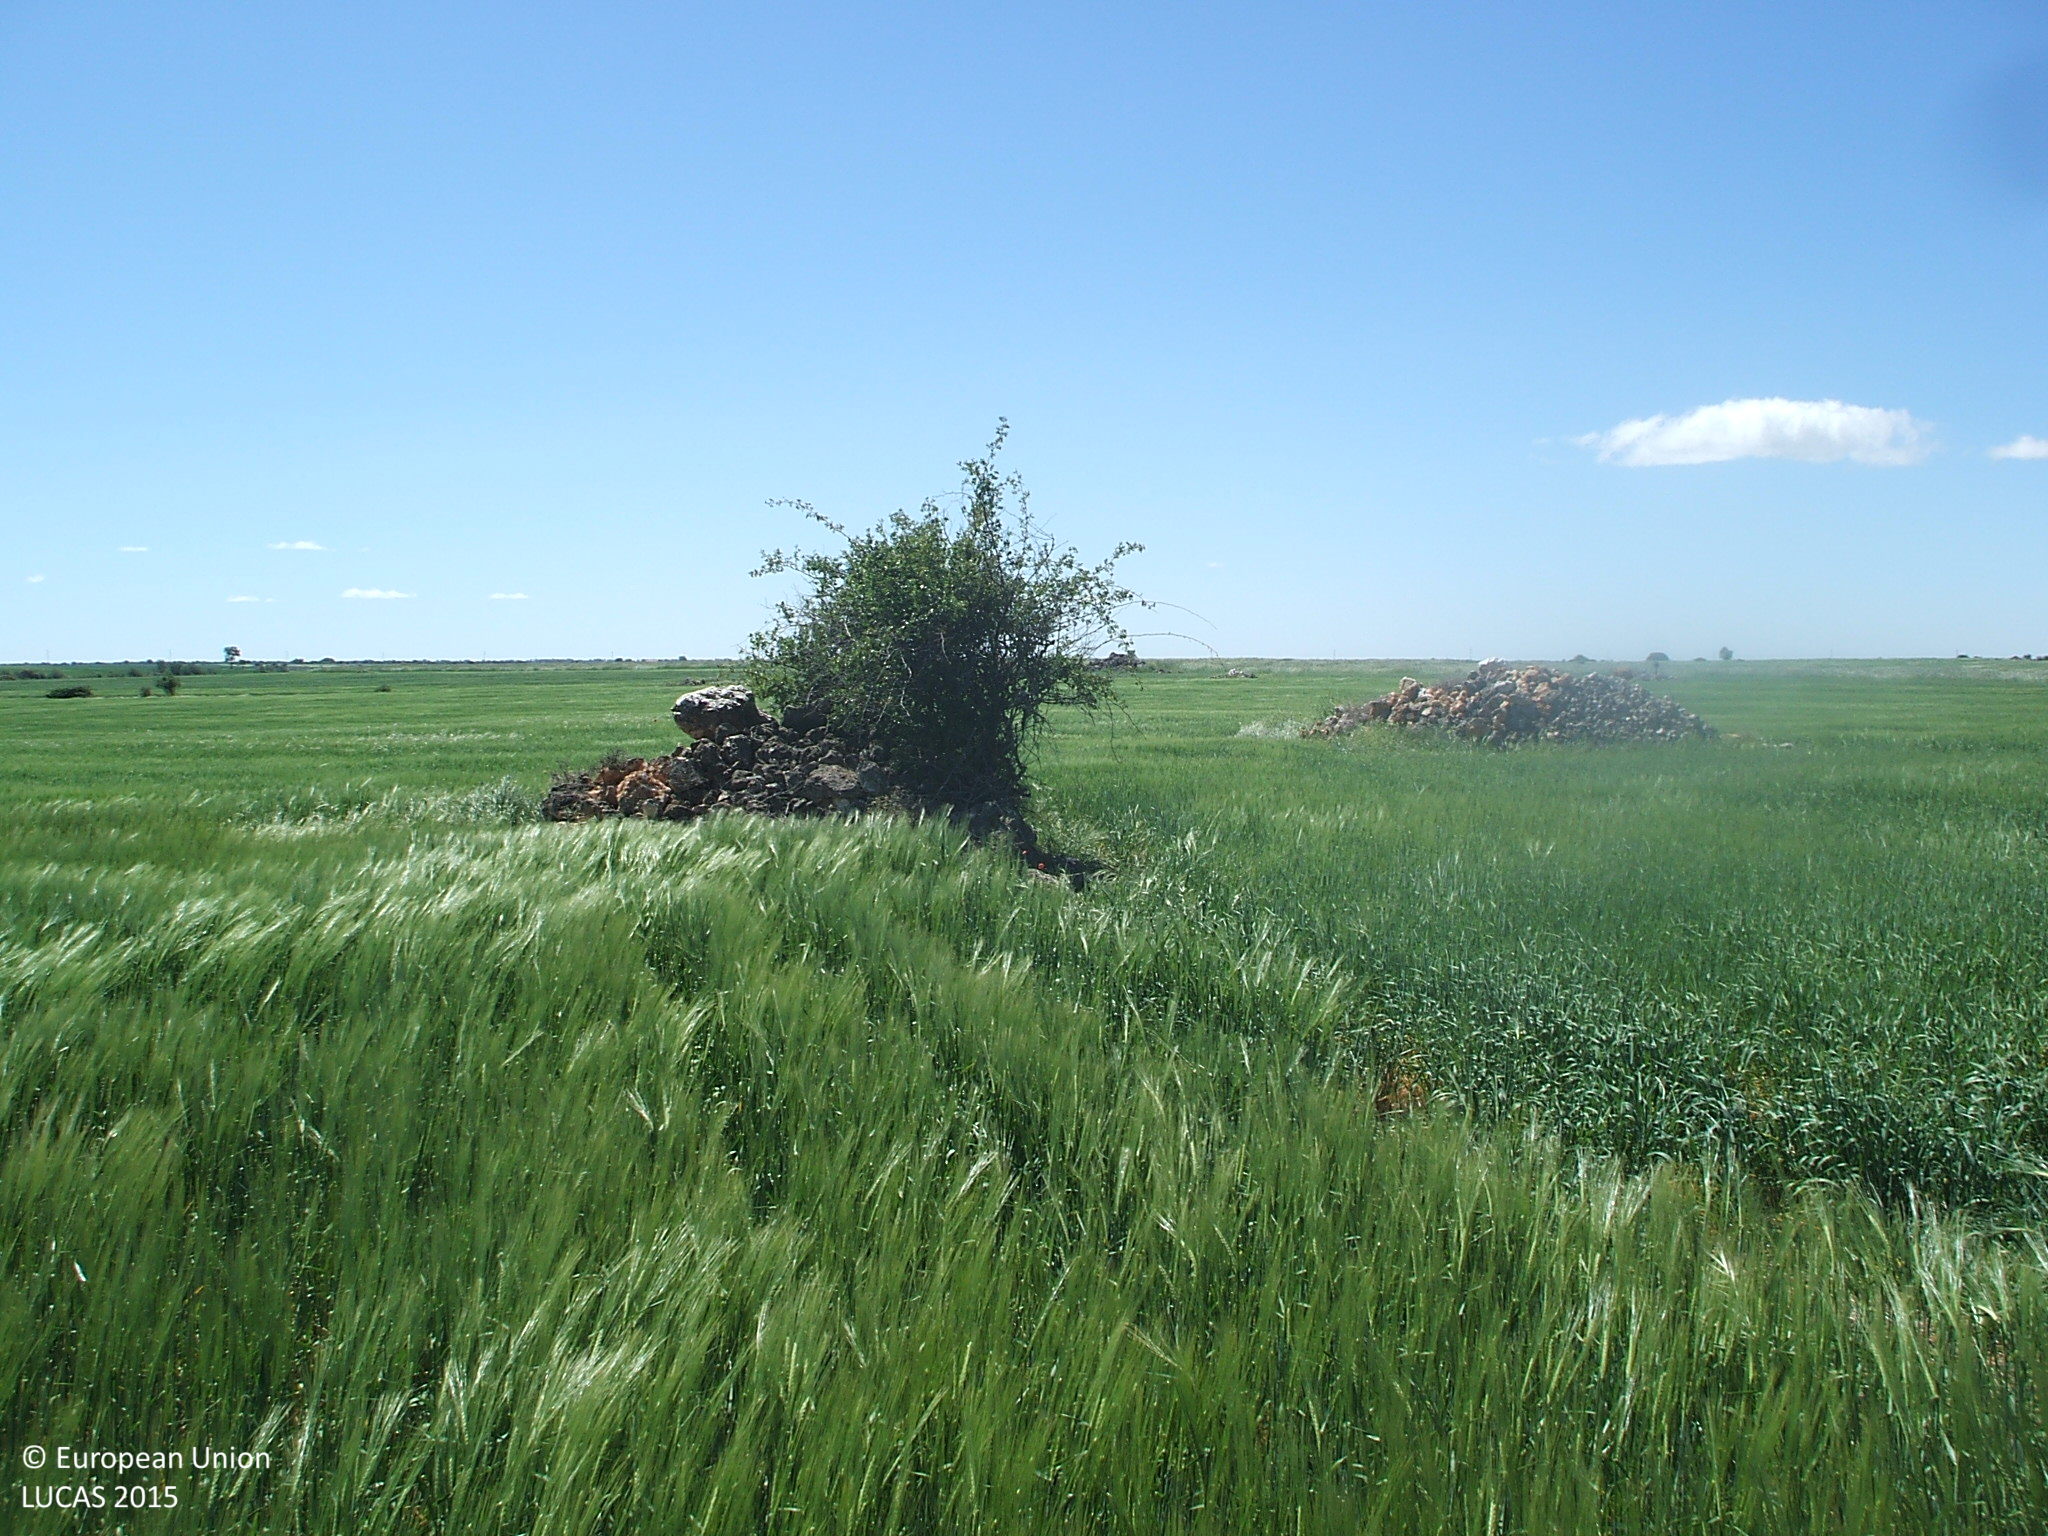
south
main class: Cropland
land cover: Barley
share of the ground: > 75 %
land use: Agriculture (excluding fallow land and kitchen gardens)
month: May
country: ES
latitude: 40.8980
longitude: -2.8647
